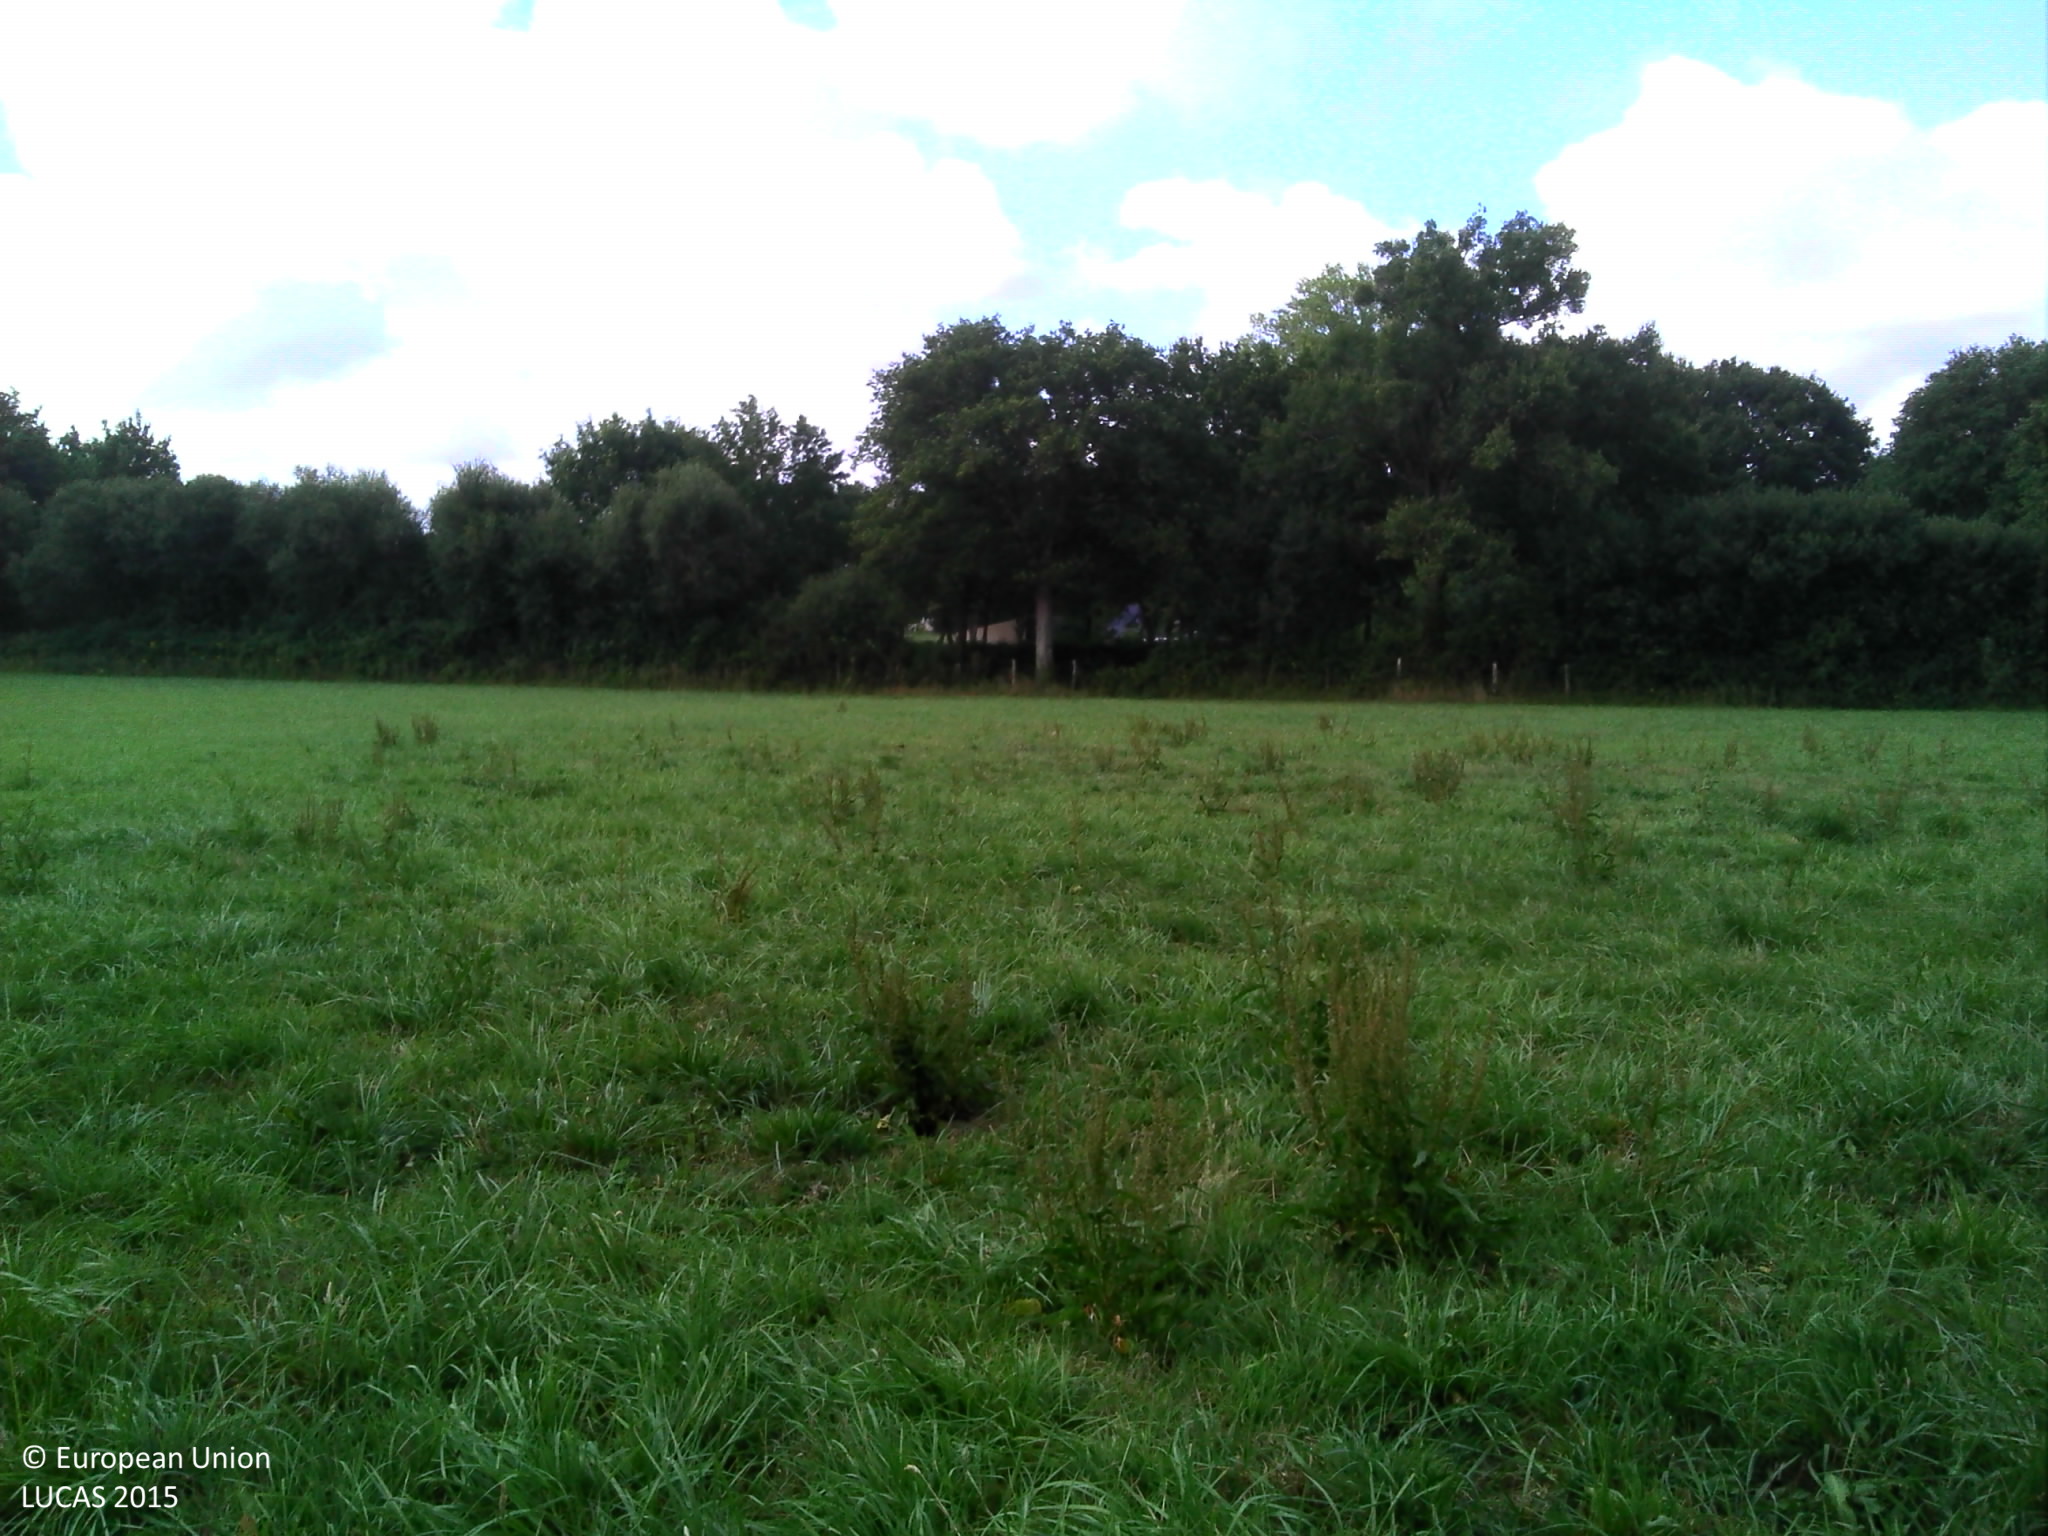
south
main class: Cropland
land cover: Temporary grasslands
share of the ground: > 75 %
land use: Agriculture (excluding fallow land and kitchen gardens)
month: July
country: FR
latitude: 47.3748
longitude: -1.5786
